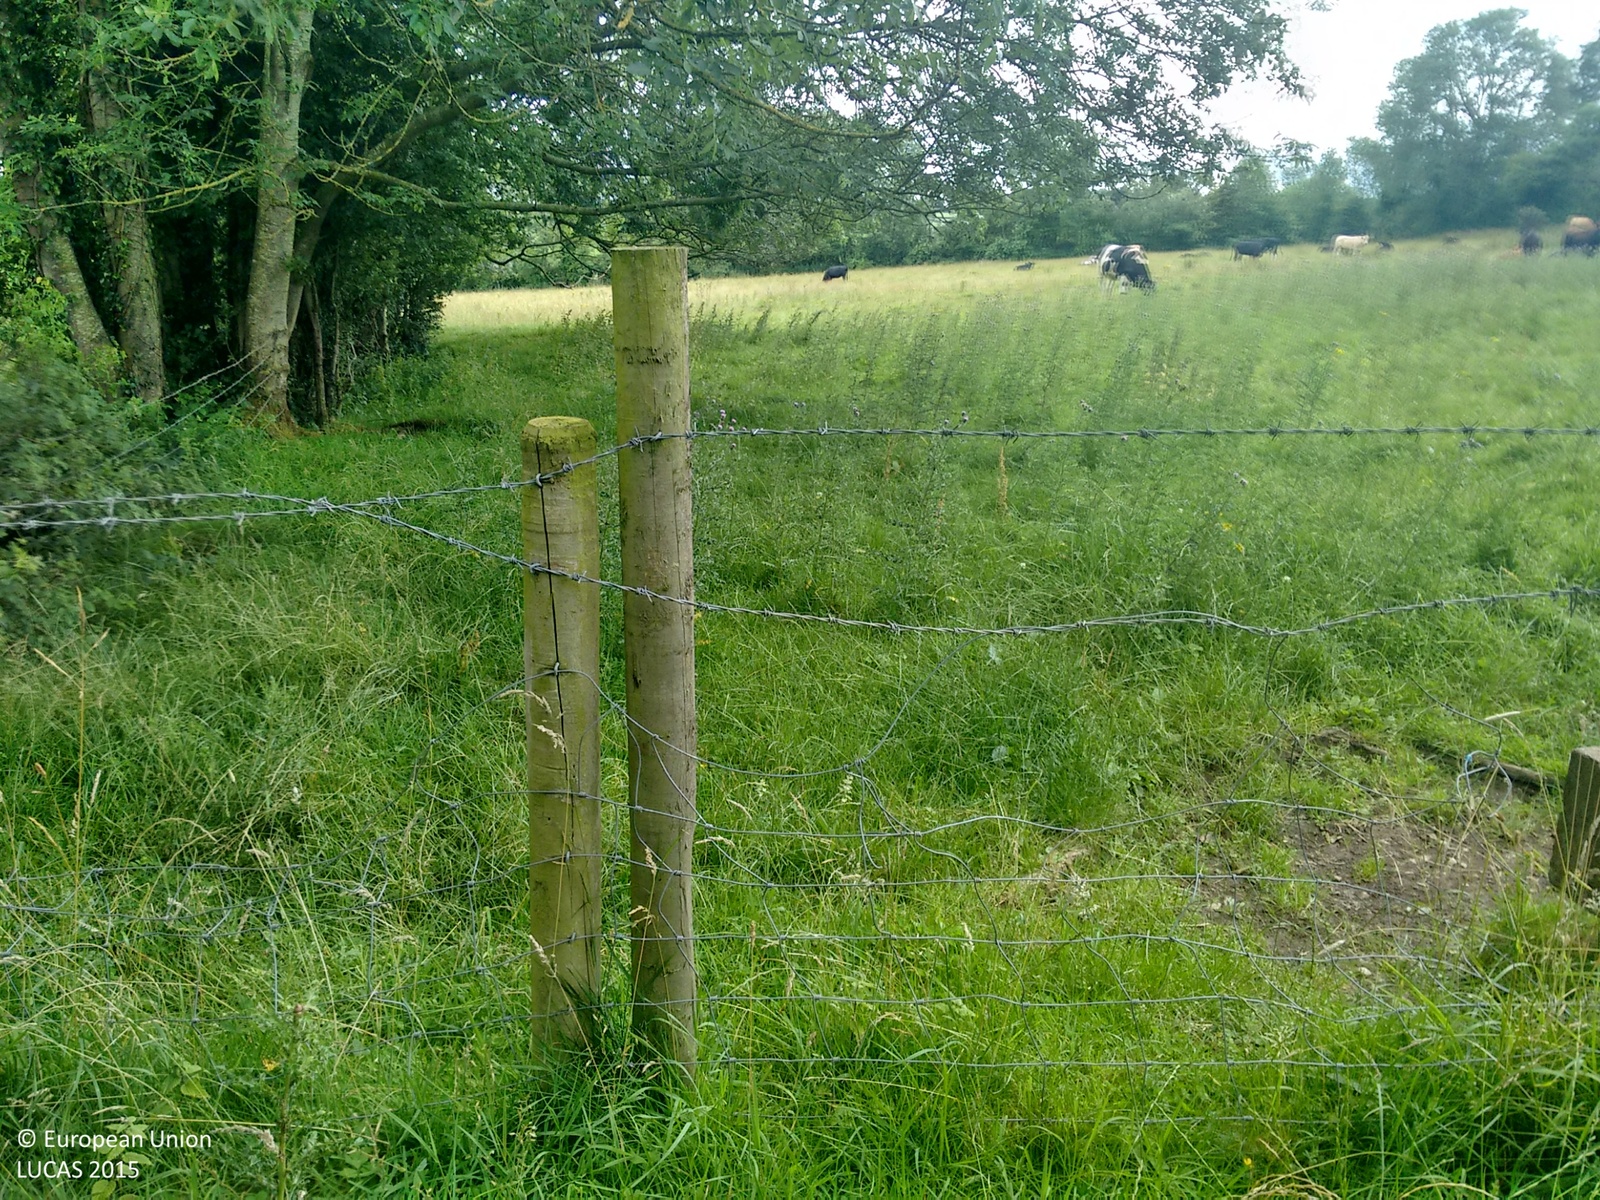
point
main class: Grassland
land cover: Grassland without tree/shrub cover
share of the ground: > 75 %
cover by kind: herbaceous plants 100 %
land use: Agriculture (excluding fallow land and kitchen gardens)
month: August
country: GB
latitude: 54.3197
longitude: -6.7514
